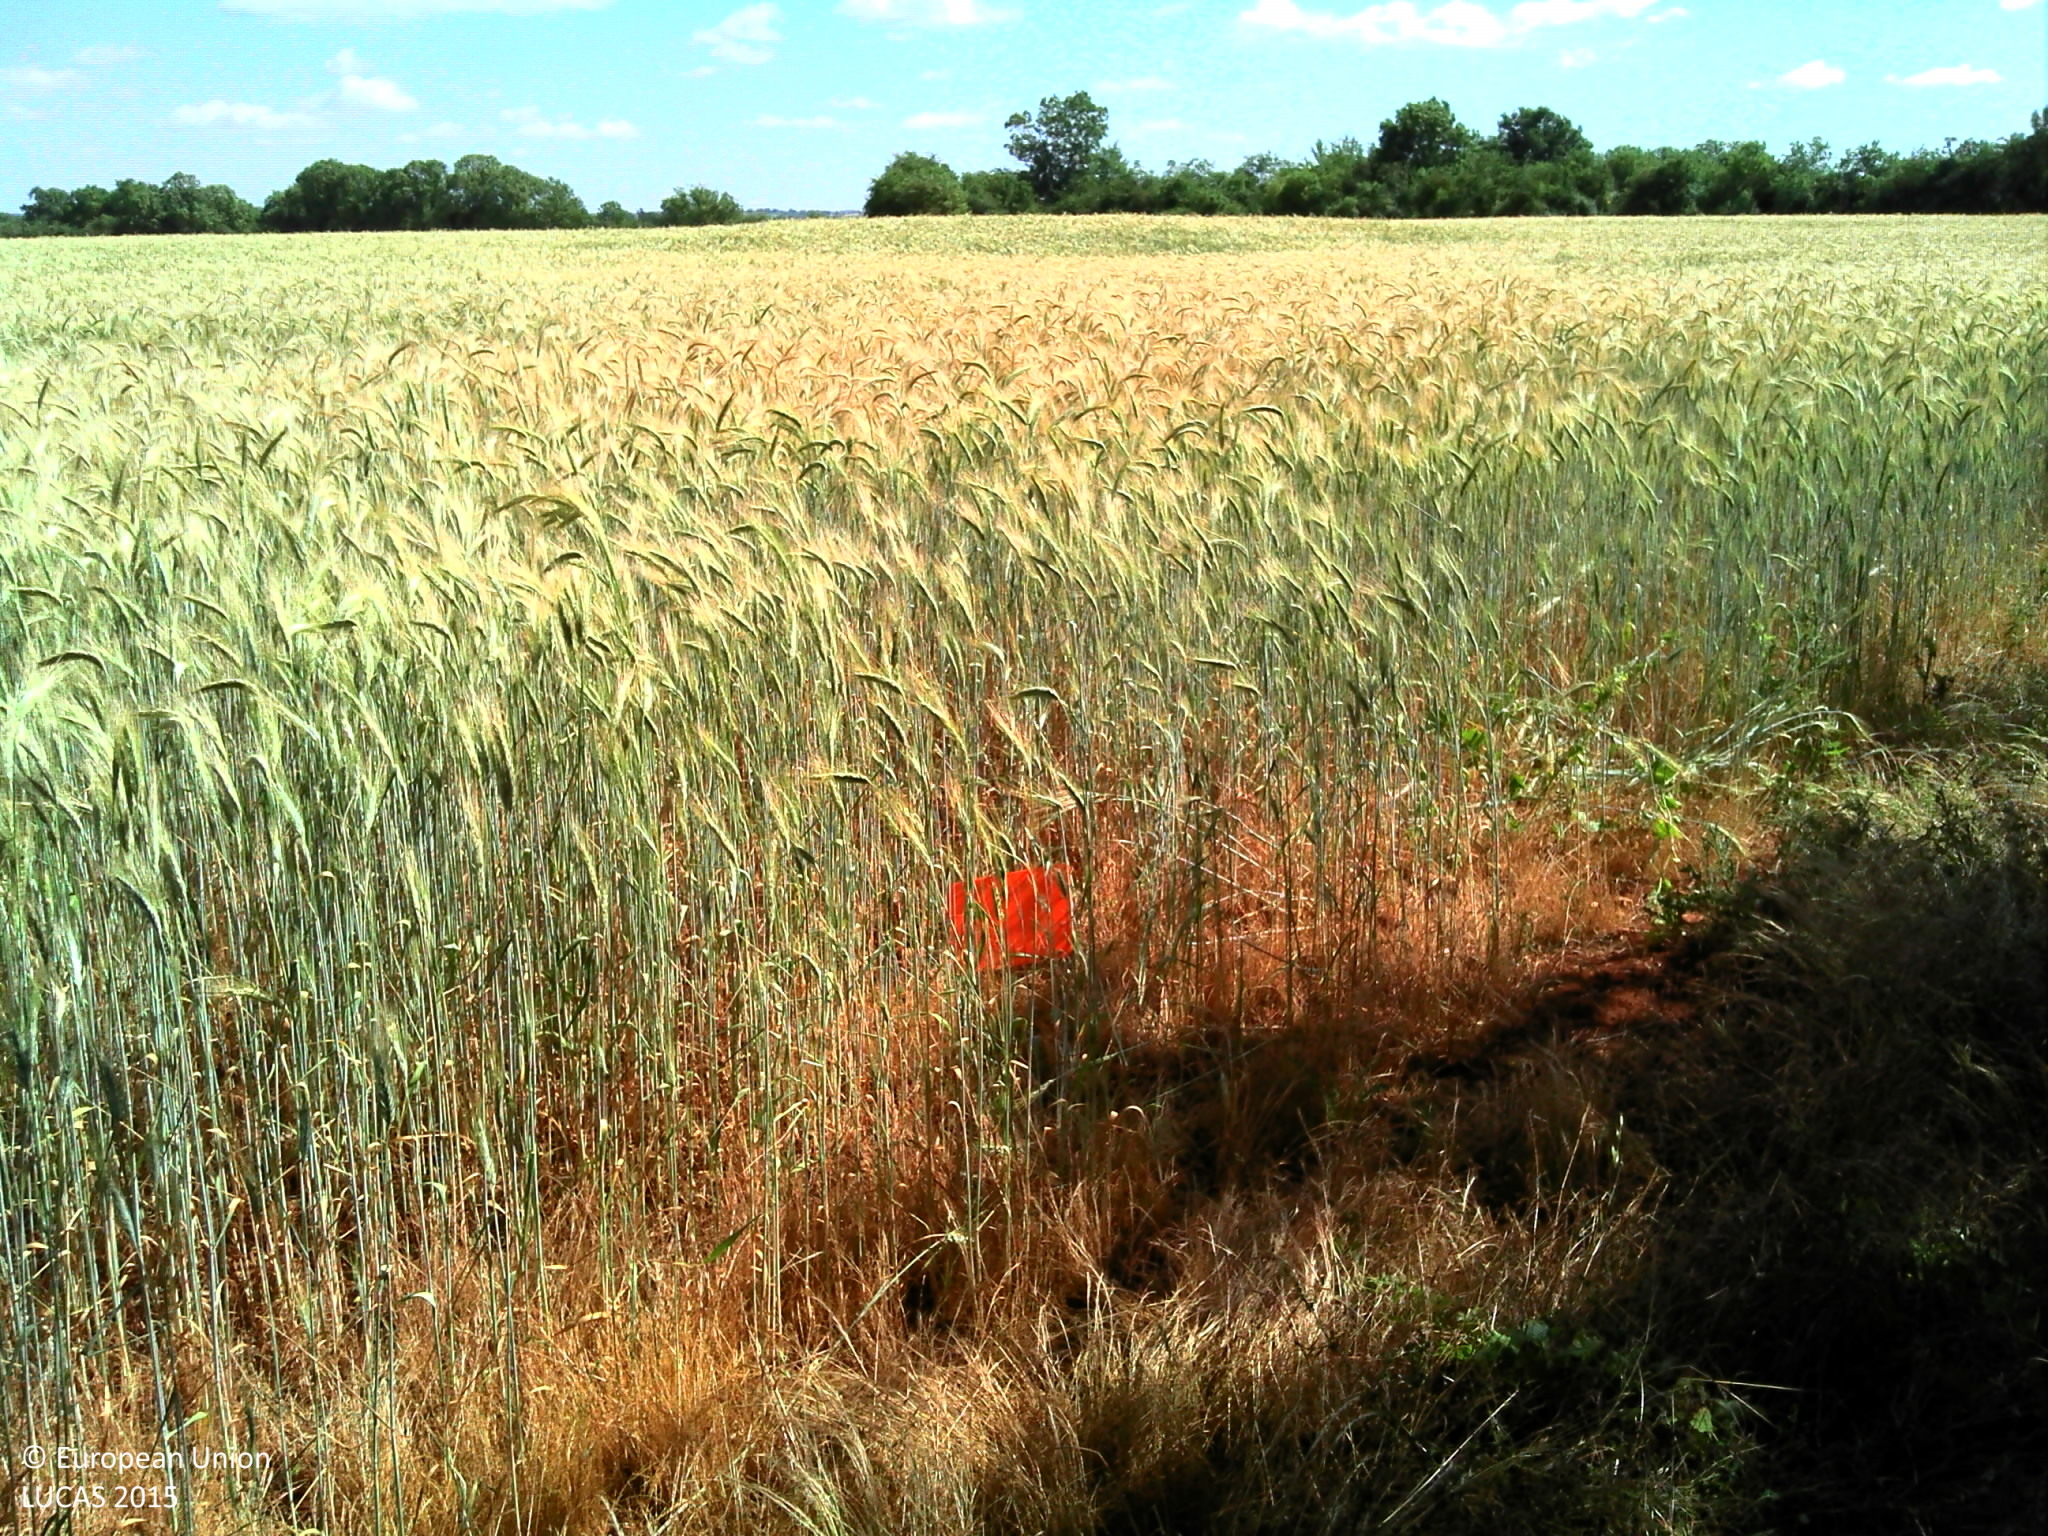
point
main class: Cropland
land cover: Triticale
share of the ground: > 75 %
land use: Agriculture (excluding fallow land and kitchen gardens)
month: June
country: FR
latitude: 44.4035
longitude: 2.4816
